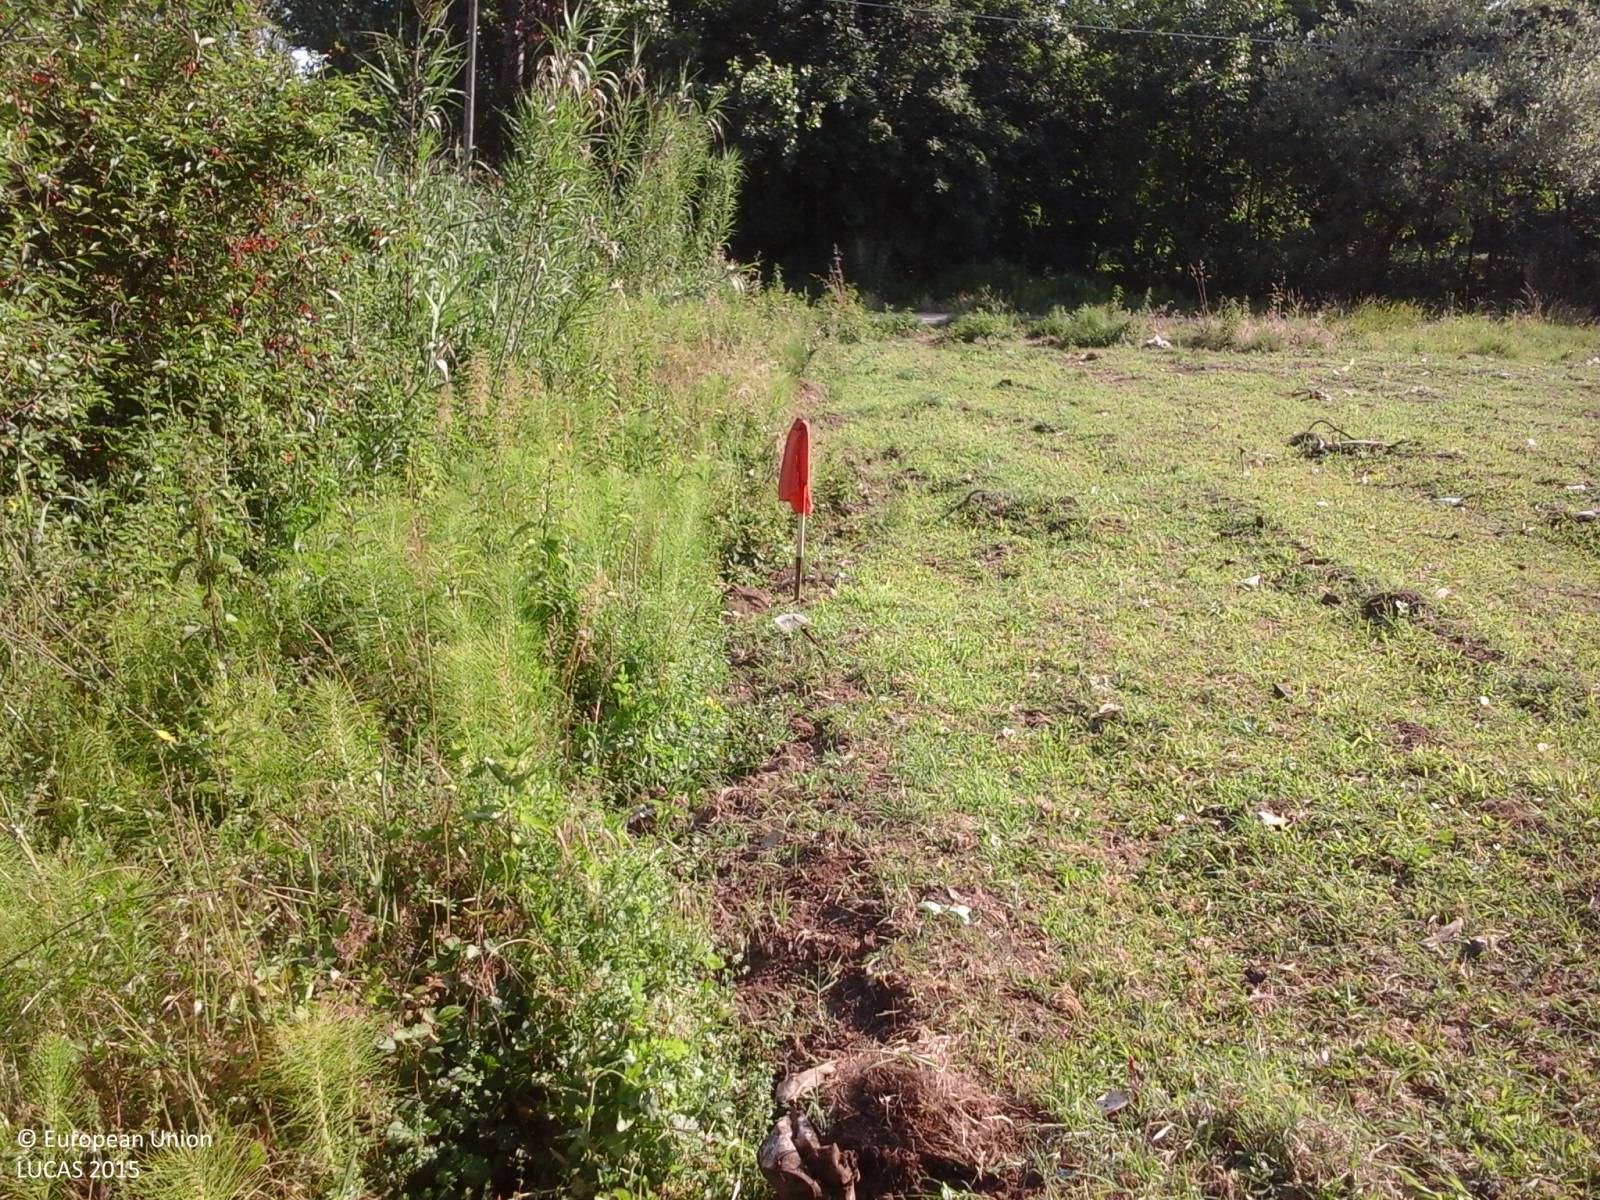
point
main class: Grassland
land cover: Spontaneously vegetated surfaces
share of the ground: > 75 %
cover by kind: herbaceous plants 100 %
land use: Agriculture (excluding fallow land and kitchen gardens)
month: June
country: IT
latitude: 41.0905
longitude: 14.4468
